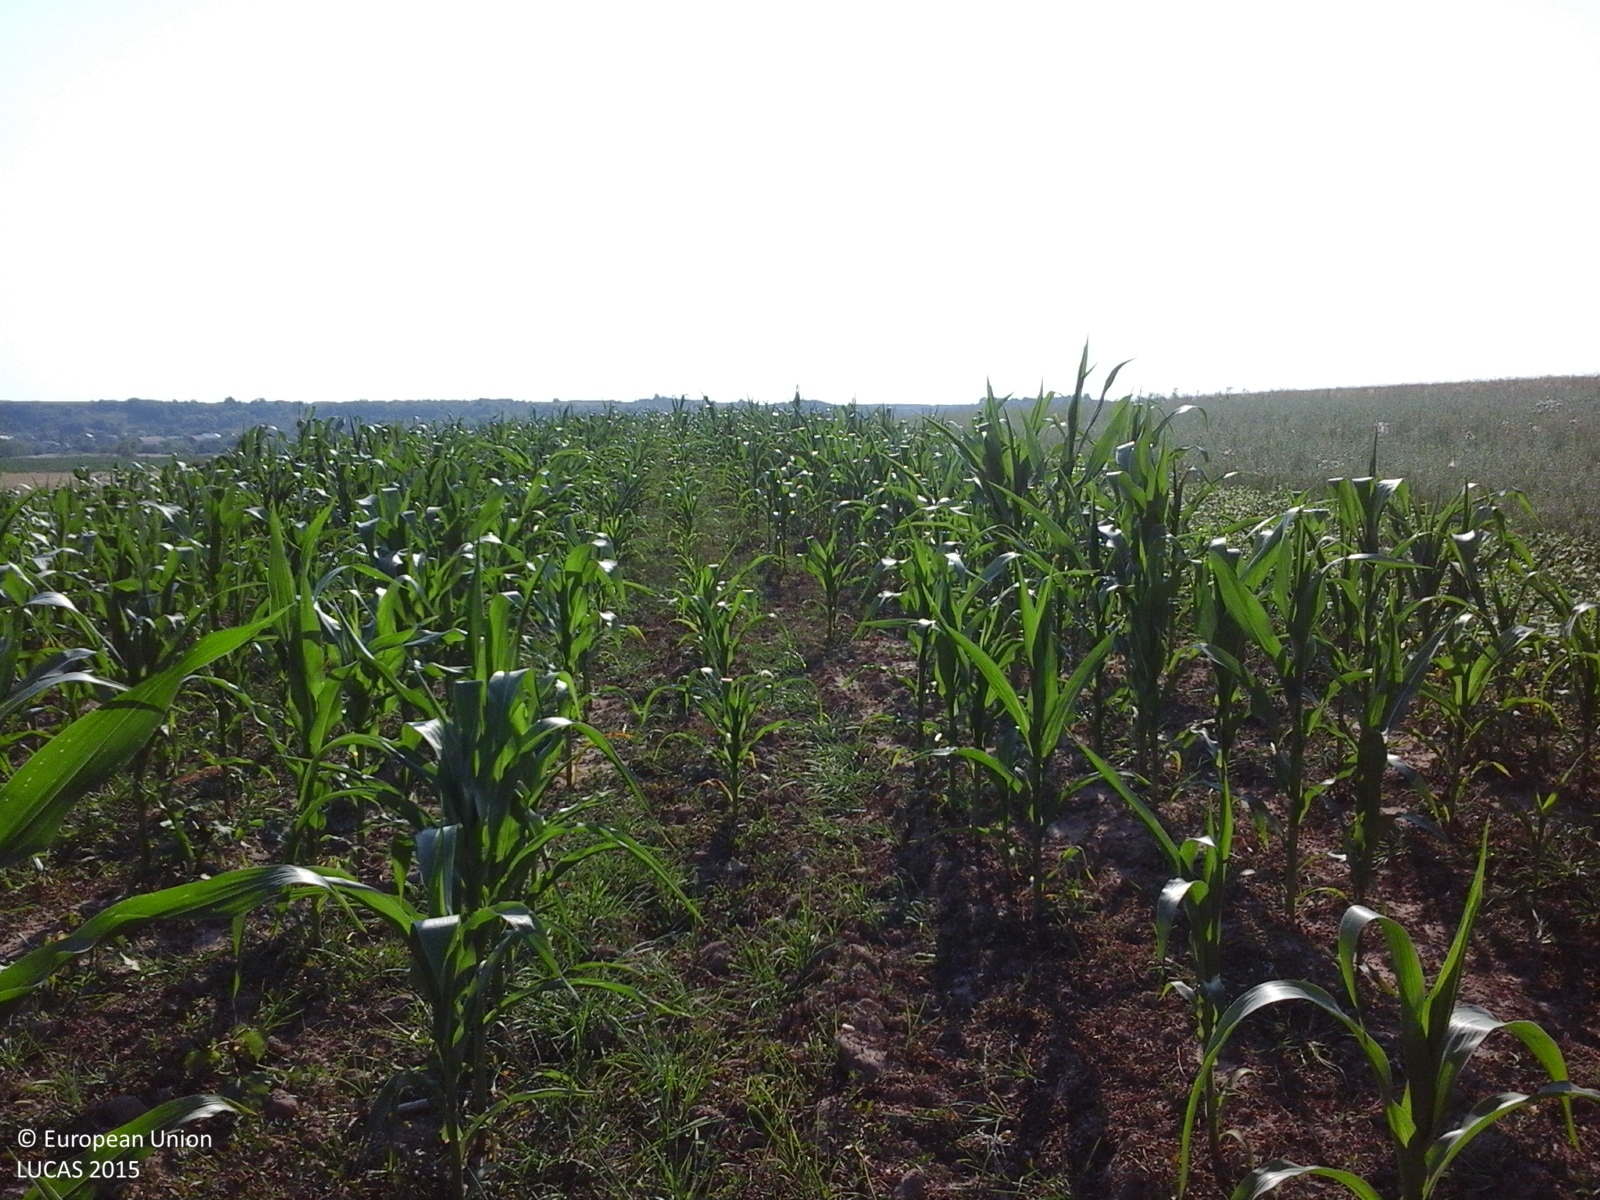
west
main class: Cropland
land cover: Maize
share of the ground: 50 - 75 %
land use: Agriculture (excluding fallow land and kitchen gardens)
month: July
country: RO
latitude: 44.6741
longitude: 24.6710
